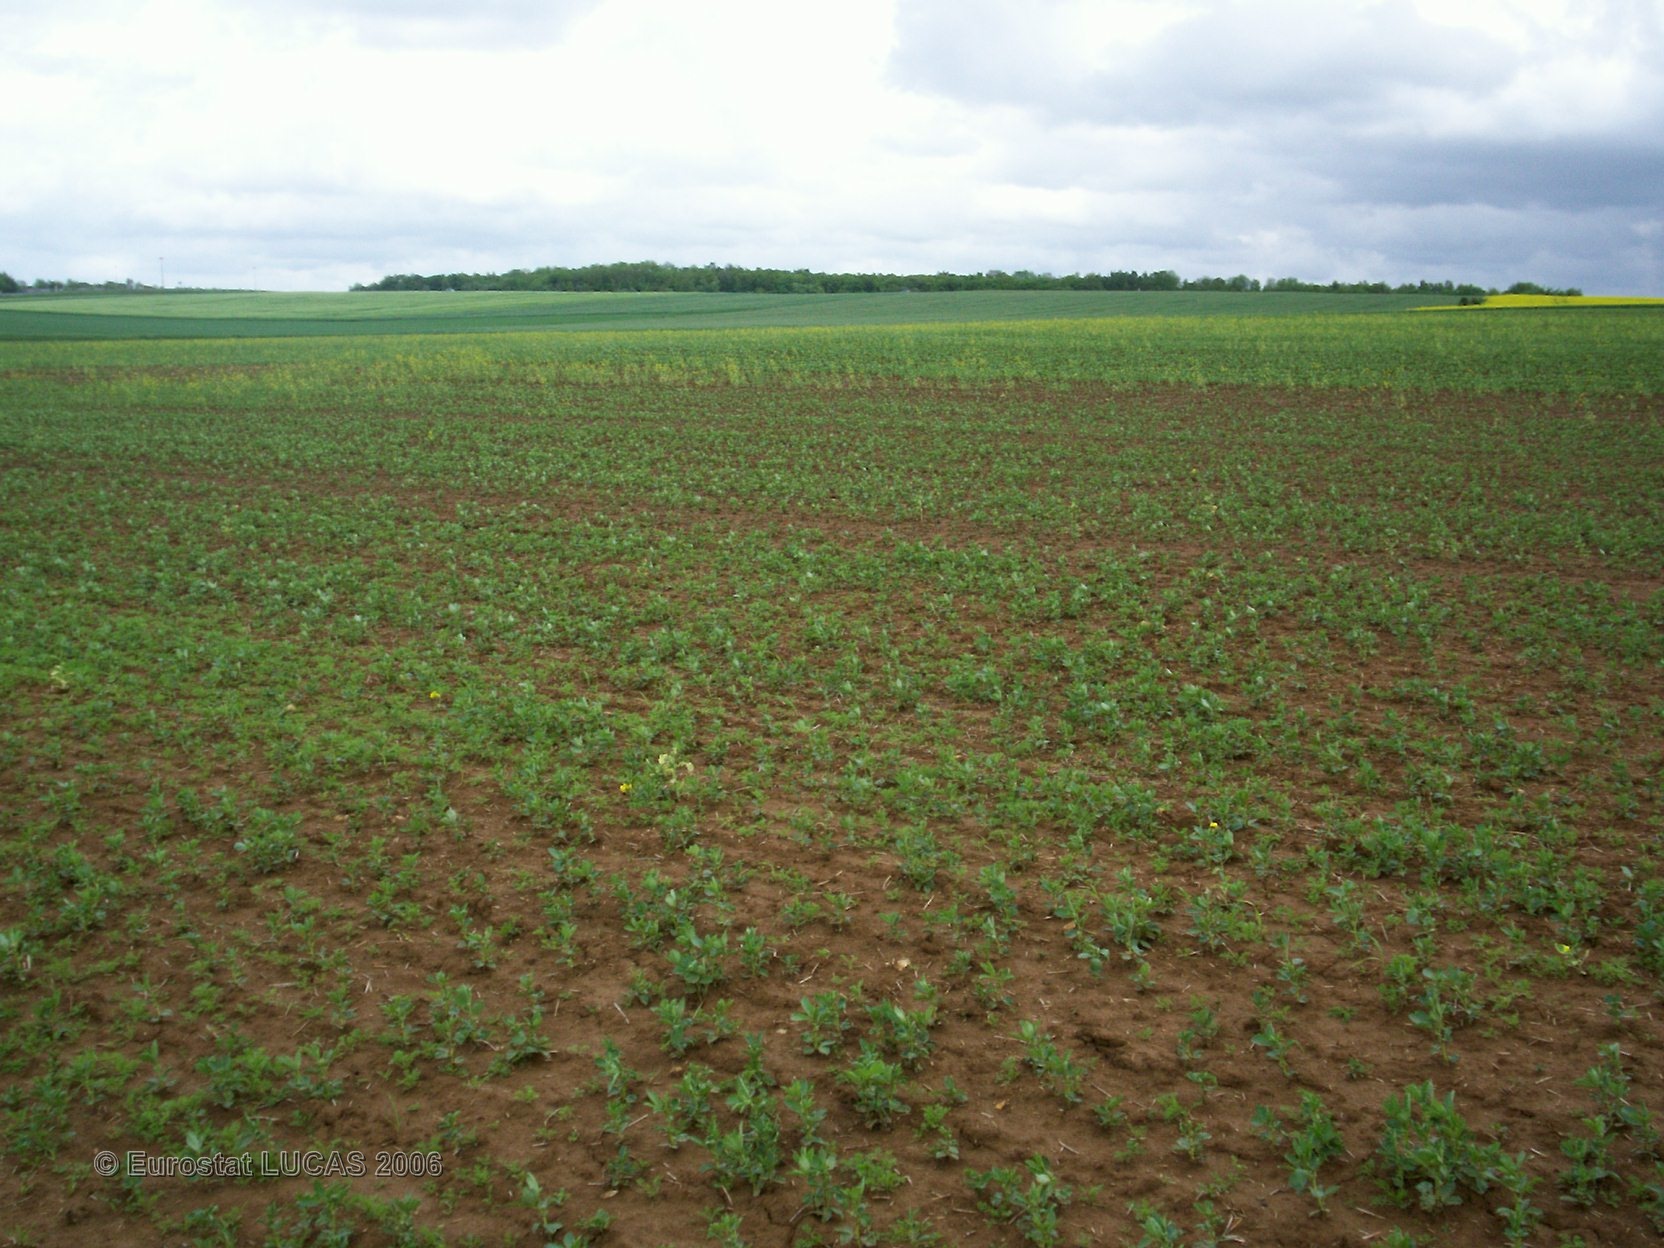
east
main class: Cropland
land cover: Barley
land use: Agriculture (excluding fallow land and kitchen gardens)
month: May
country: FR
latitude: 49.4603
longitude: 5.8463
